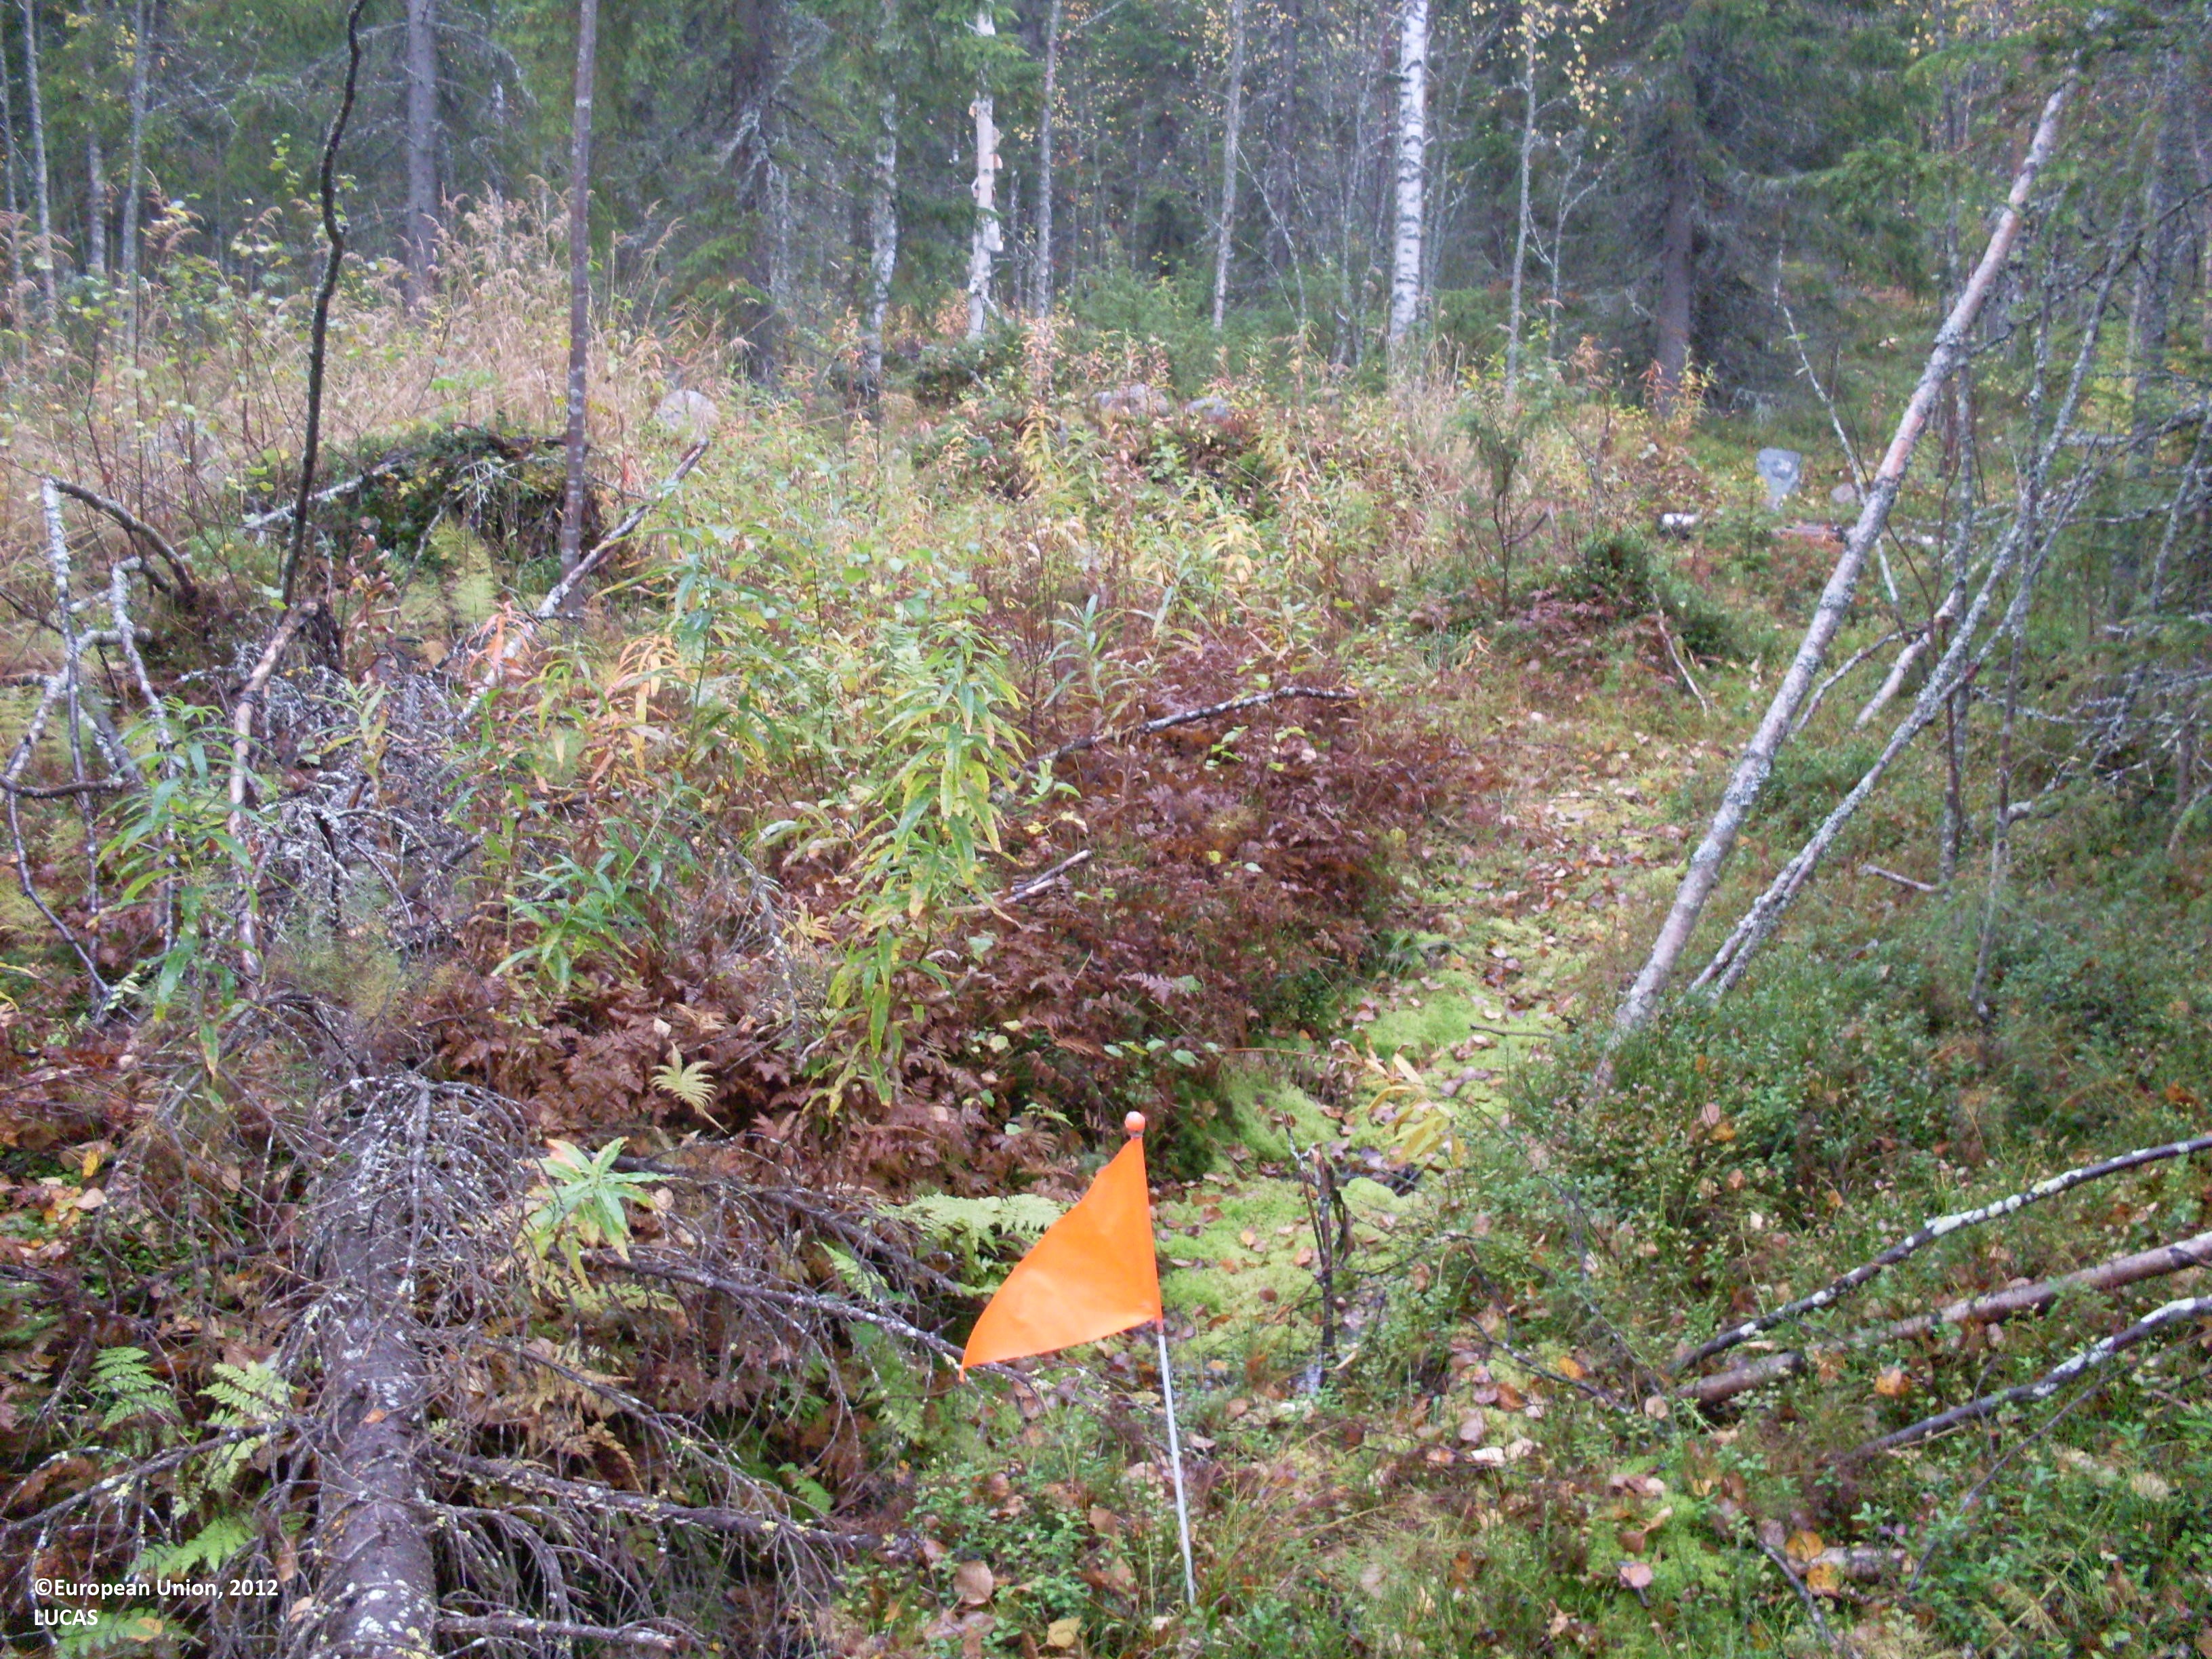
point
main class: Woodland
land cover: Spruce dominated mixed woodland
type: boreal forest
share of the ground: 50 - 75 %
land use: Forestry
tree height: > 5 m
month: September
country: FI
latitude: 64.3080
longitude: 29.3757
